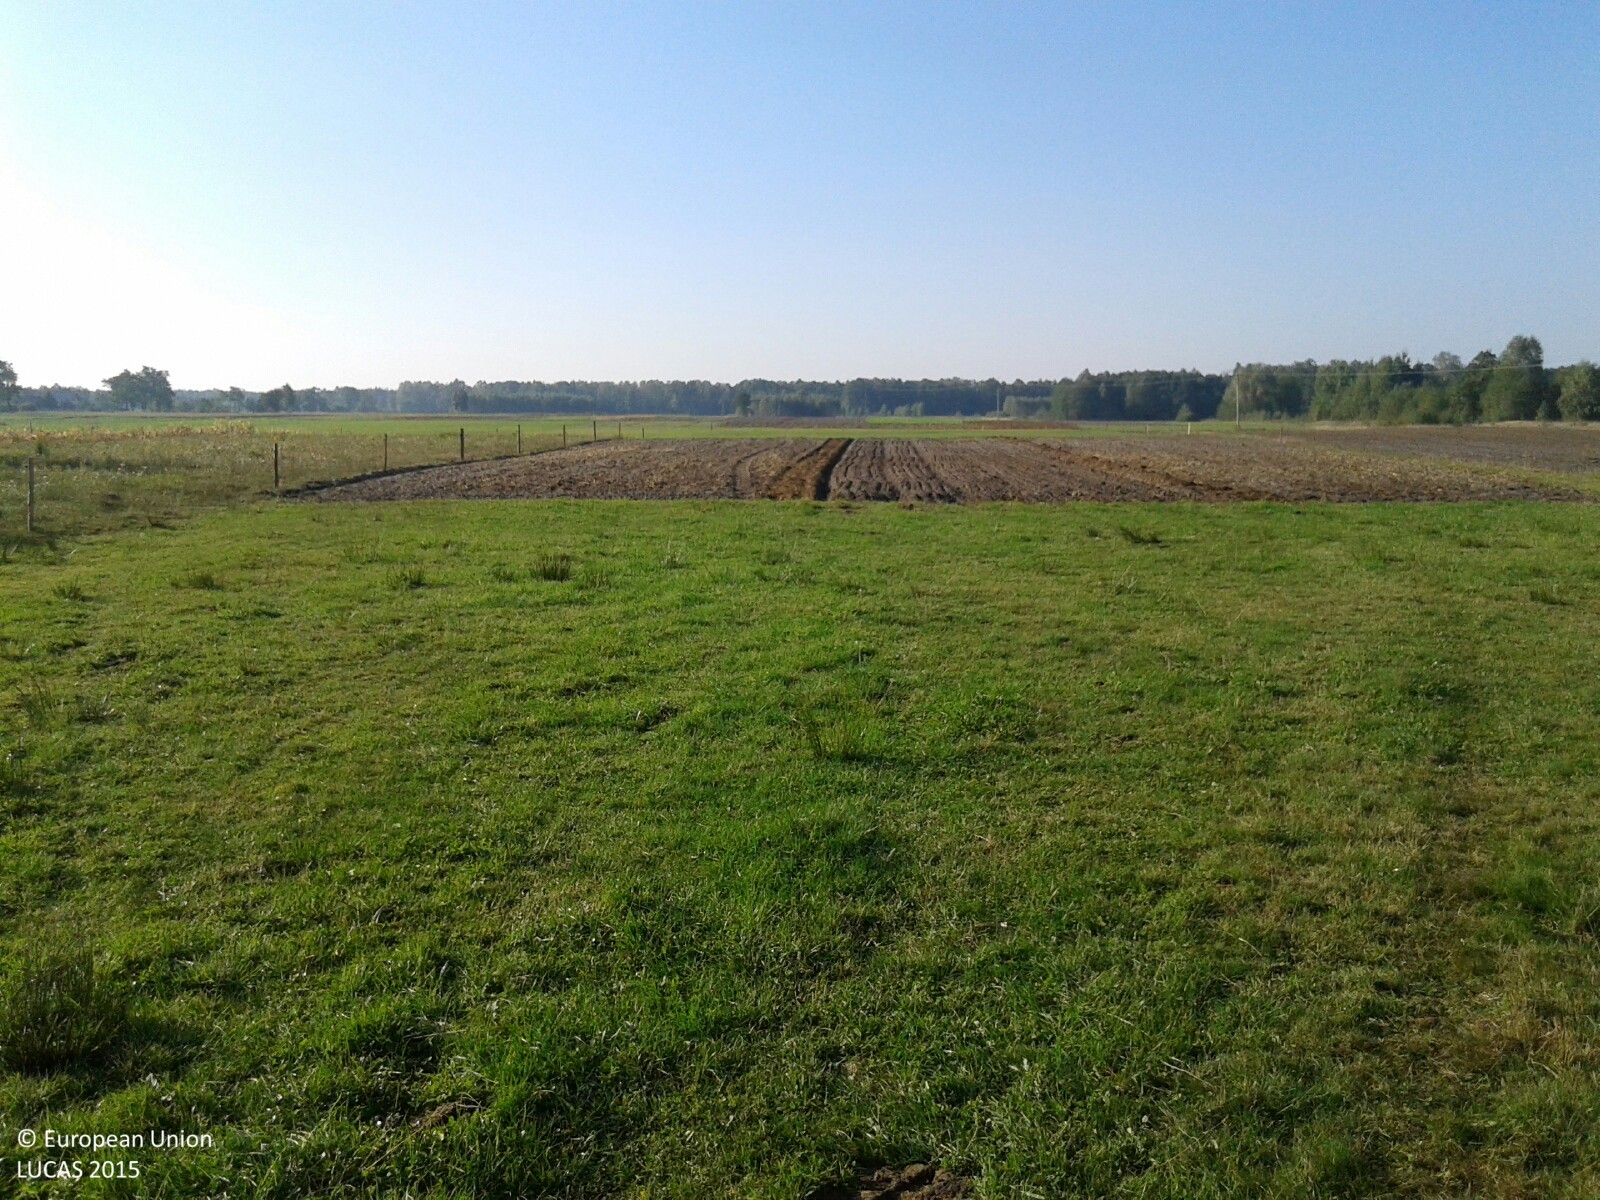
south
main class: Grassland
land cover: Grassland without tree/shrub cover
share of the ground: > 75 %
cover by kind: herbaceous plants 95 %, unconsolidated bare surface 5 %
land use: Agriculture (excluding fallow land and kitchen gardens)
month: September
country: PL
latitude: 52.6258
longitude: 21.9497
